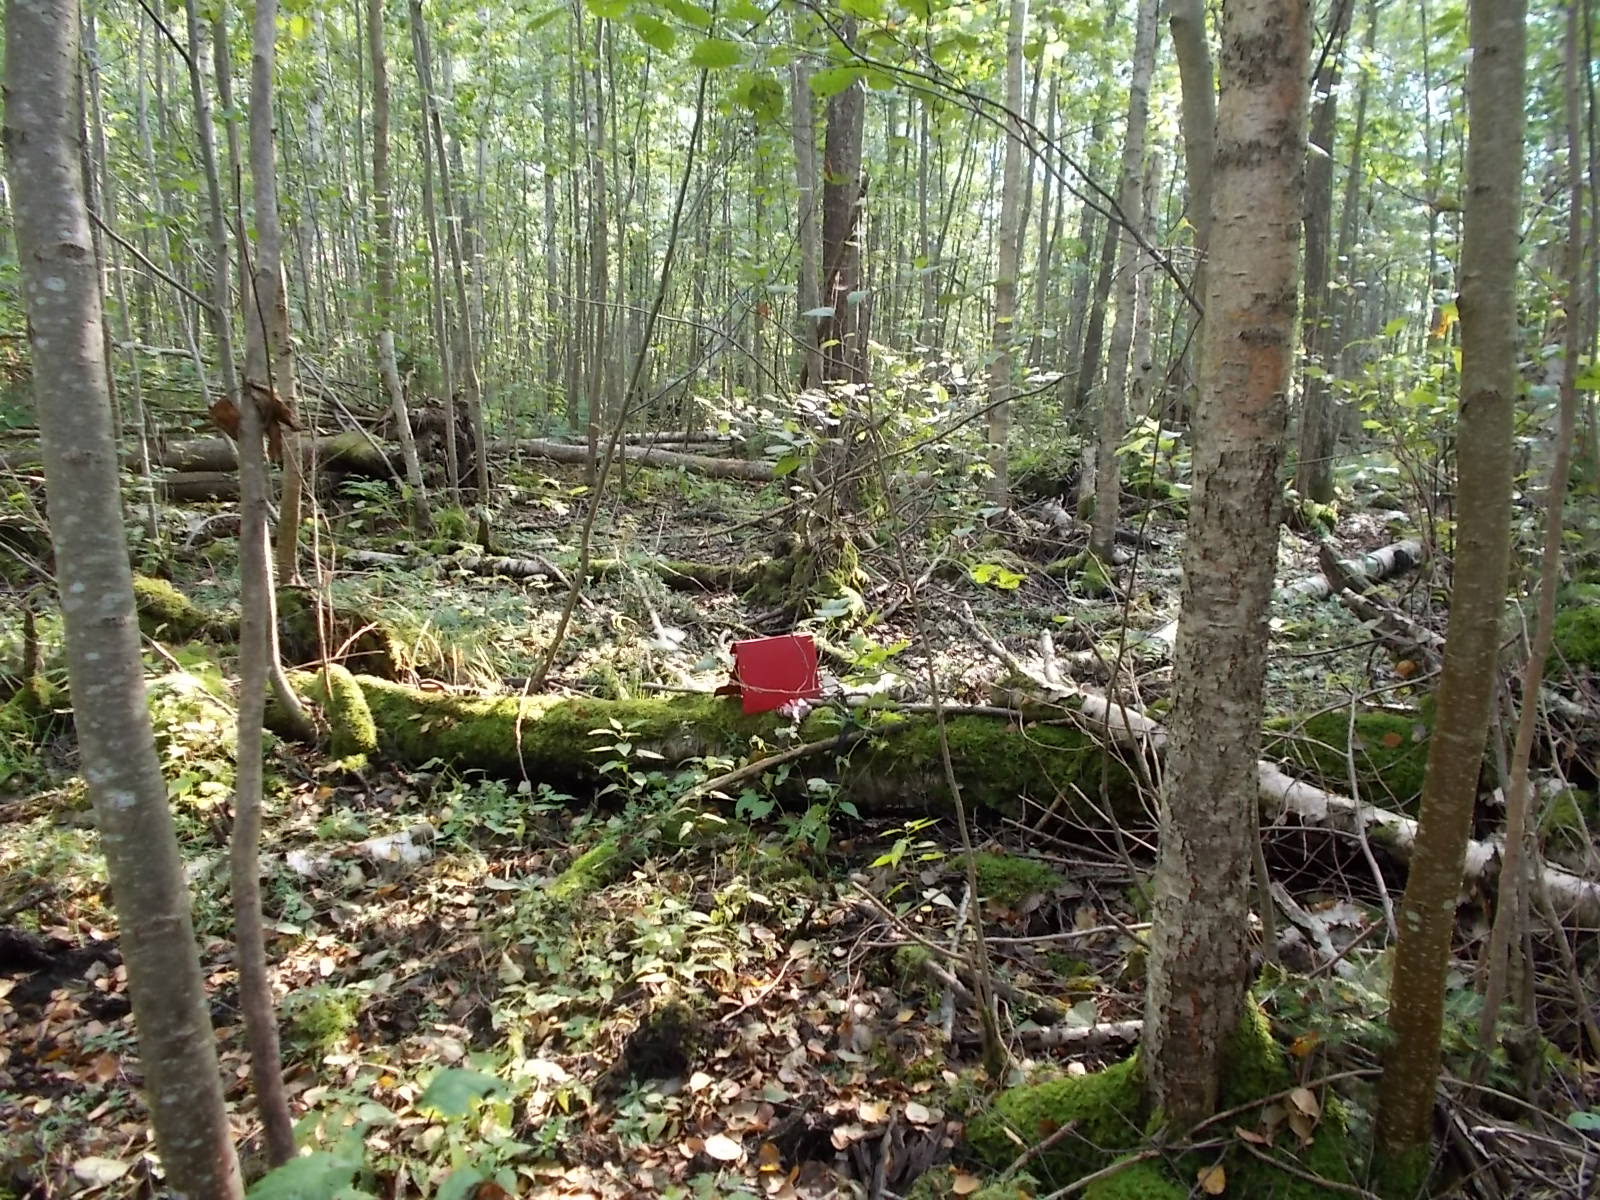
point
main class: Woodland
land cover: Broadleaved woodland
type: mire and swamp forests
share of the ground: > 75 %
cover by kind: broadleaved forest trees 90 %, herbaceous plants 10 %
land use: Forestry
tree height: > 5 m
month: September
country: LV
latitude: 56.9245
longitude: 23.5629
